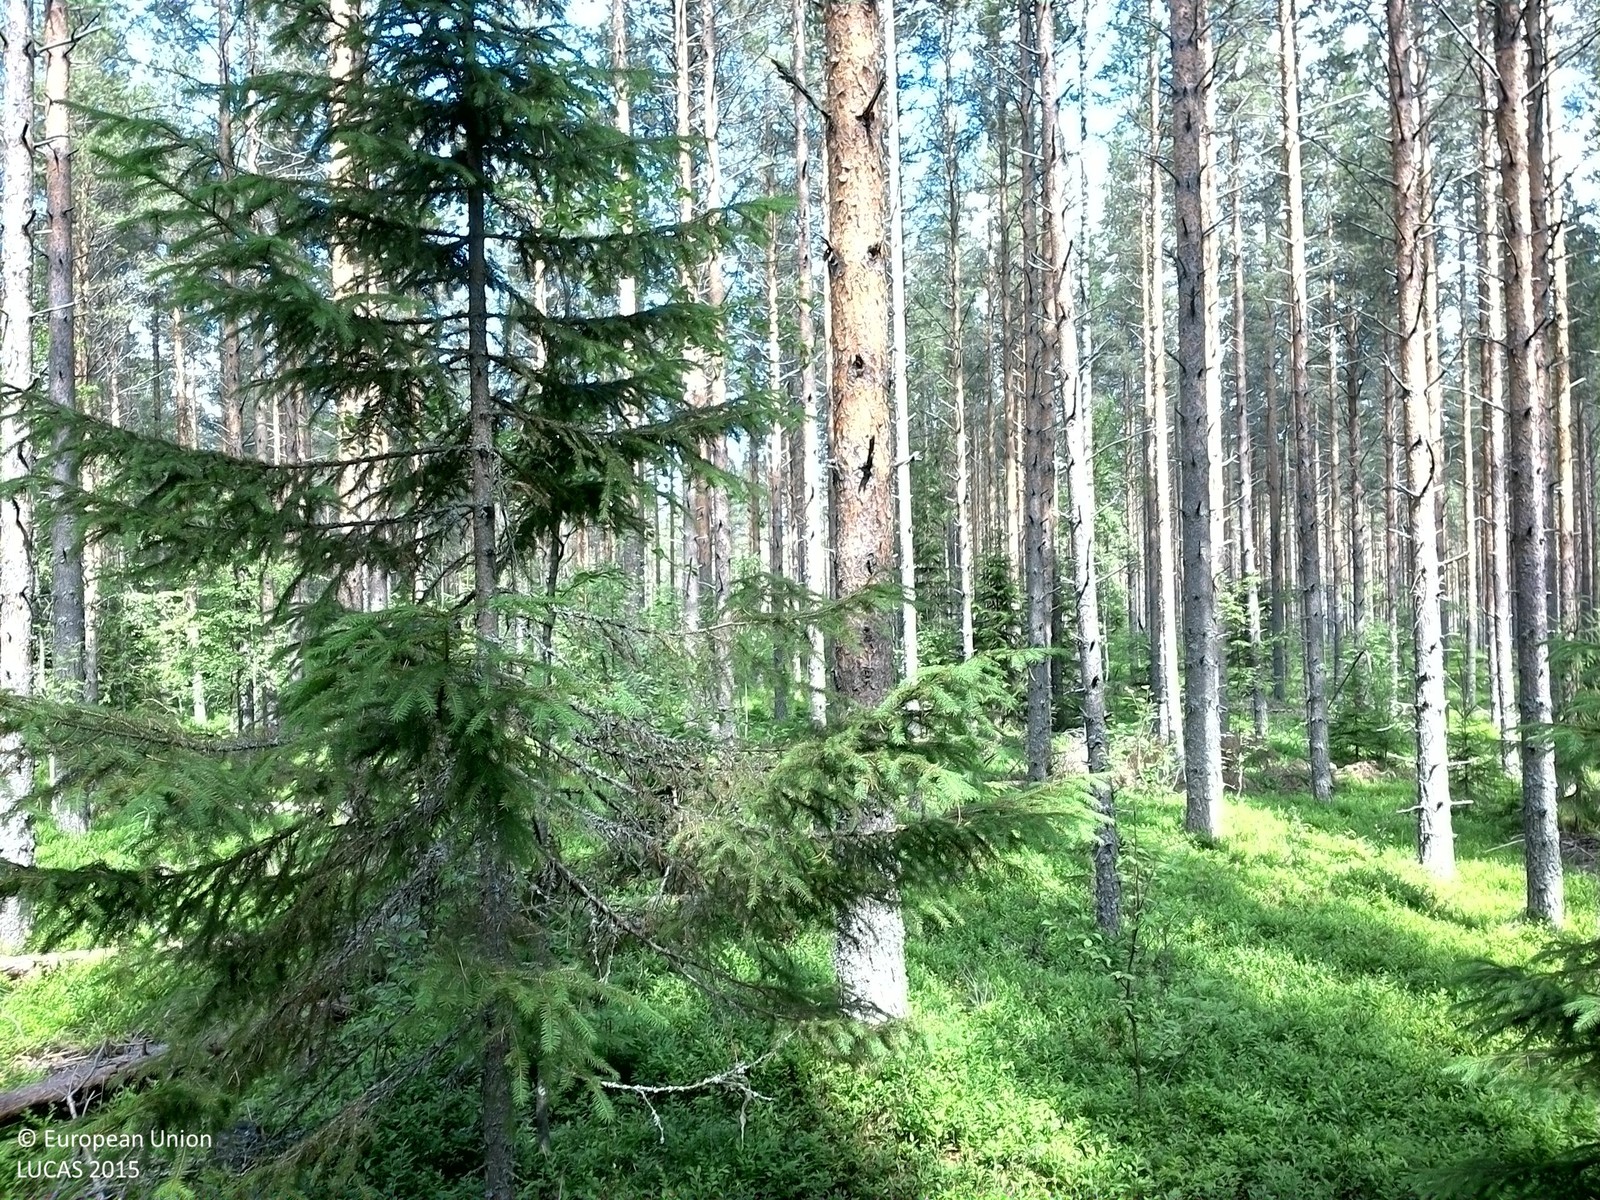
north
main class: Woodland
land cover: Pine dominated coniferous woodland
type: boreal forest
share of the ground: 50 - 75 %
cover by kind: coniferous forest trees 50 %, shrubs 40 %, broadleaved forest trees 10 %
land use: Forestry
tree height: > 5 m
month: July
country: SE
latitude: 63.4992
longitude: 18.4728
